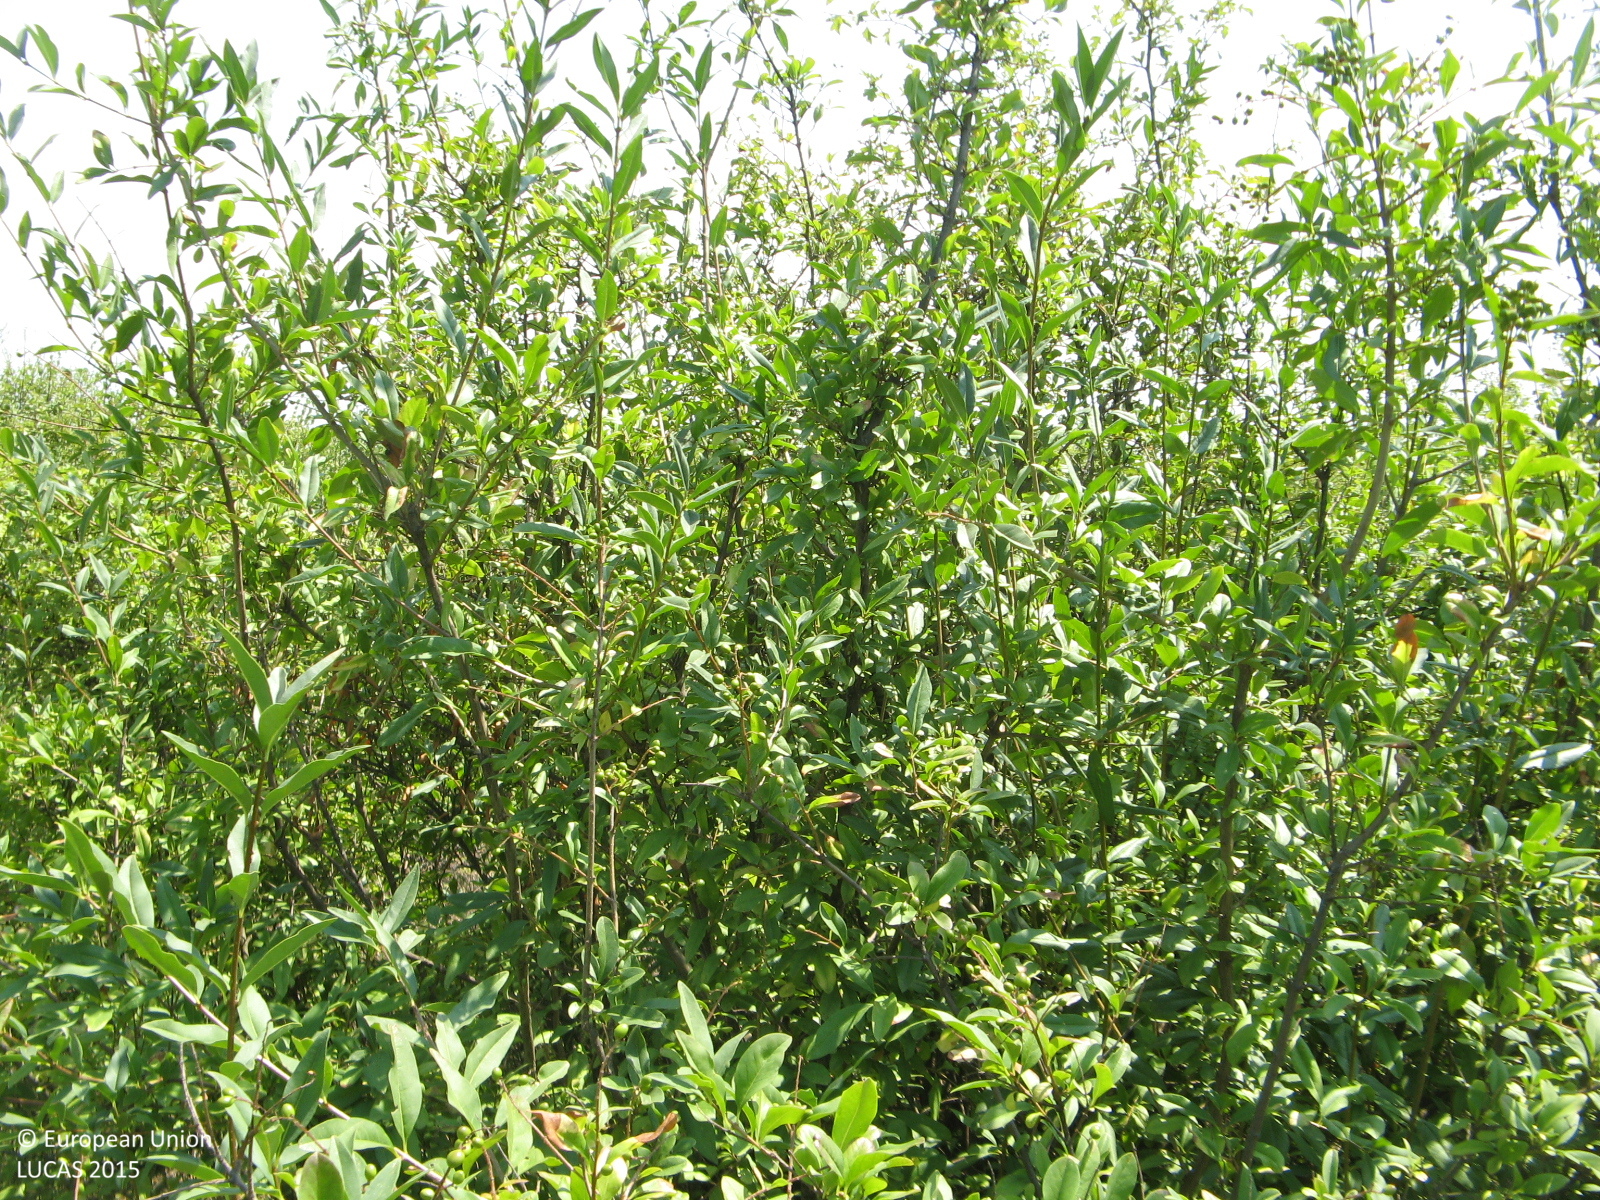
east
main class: Shrubland
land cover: Shrubland with sparse tree cover
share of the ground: > 75 %
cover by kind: shrubs 90 %, broadleaved forest trees 5 %, herbaceous plants 5 %
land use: Abandoned areas
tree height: < 5 m
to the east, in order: Shrubland with sparse tree cover
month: August
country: BG
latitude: 43.3739
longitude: 25.2933
